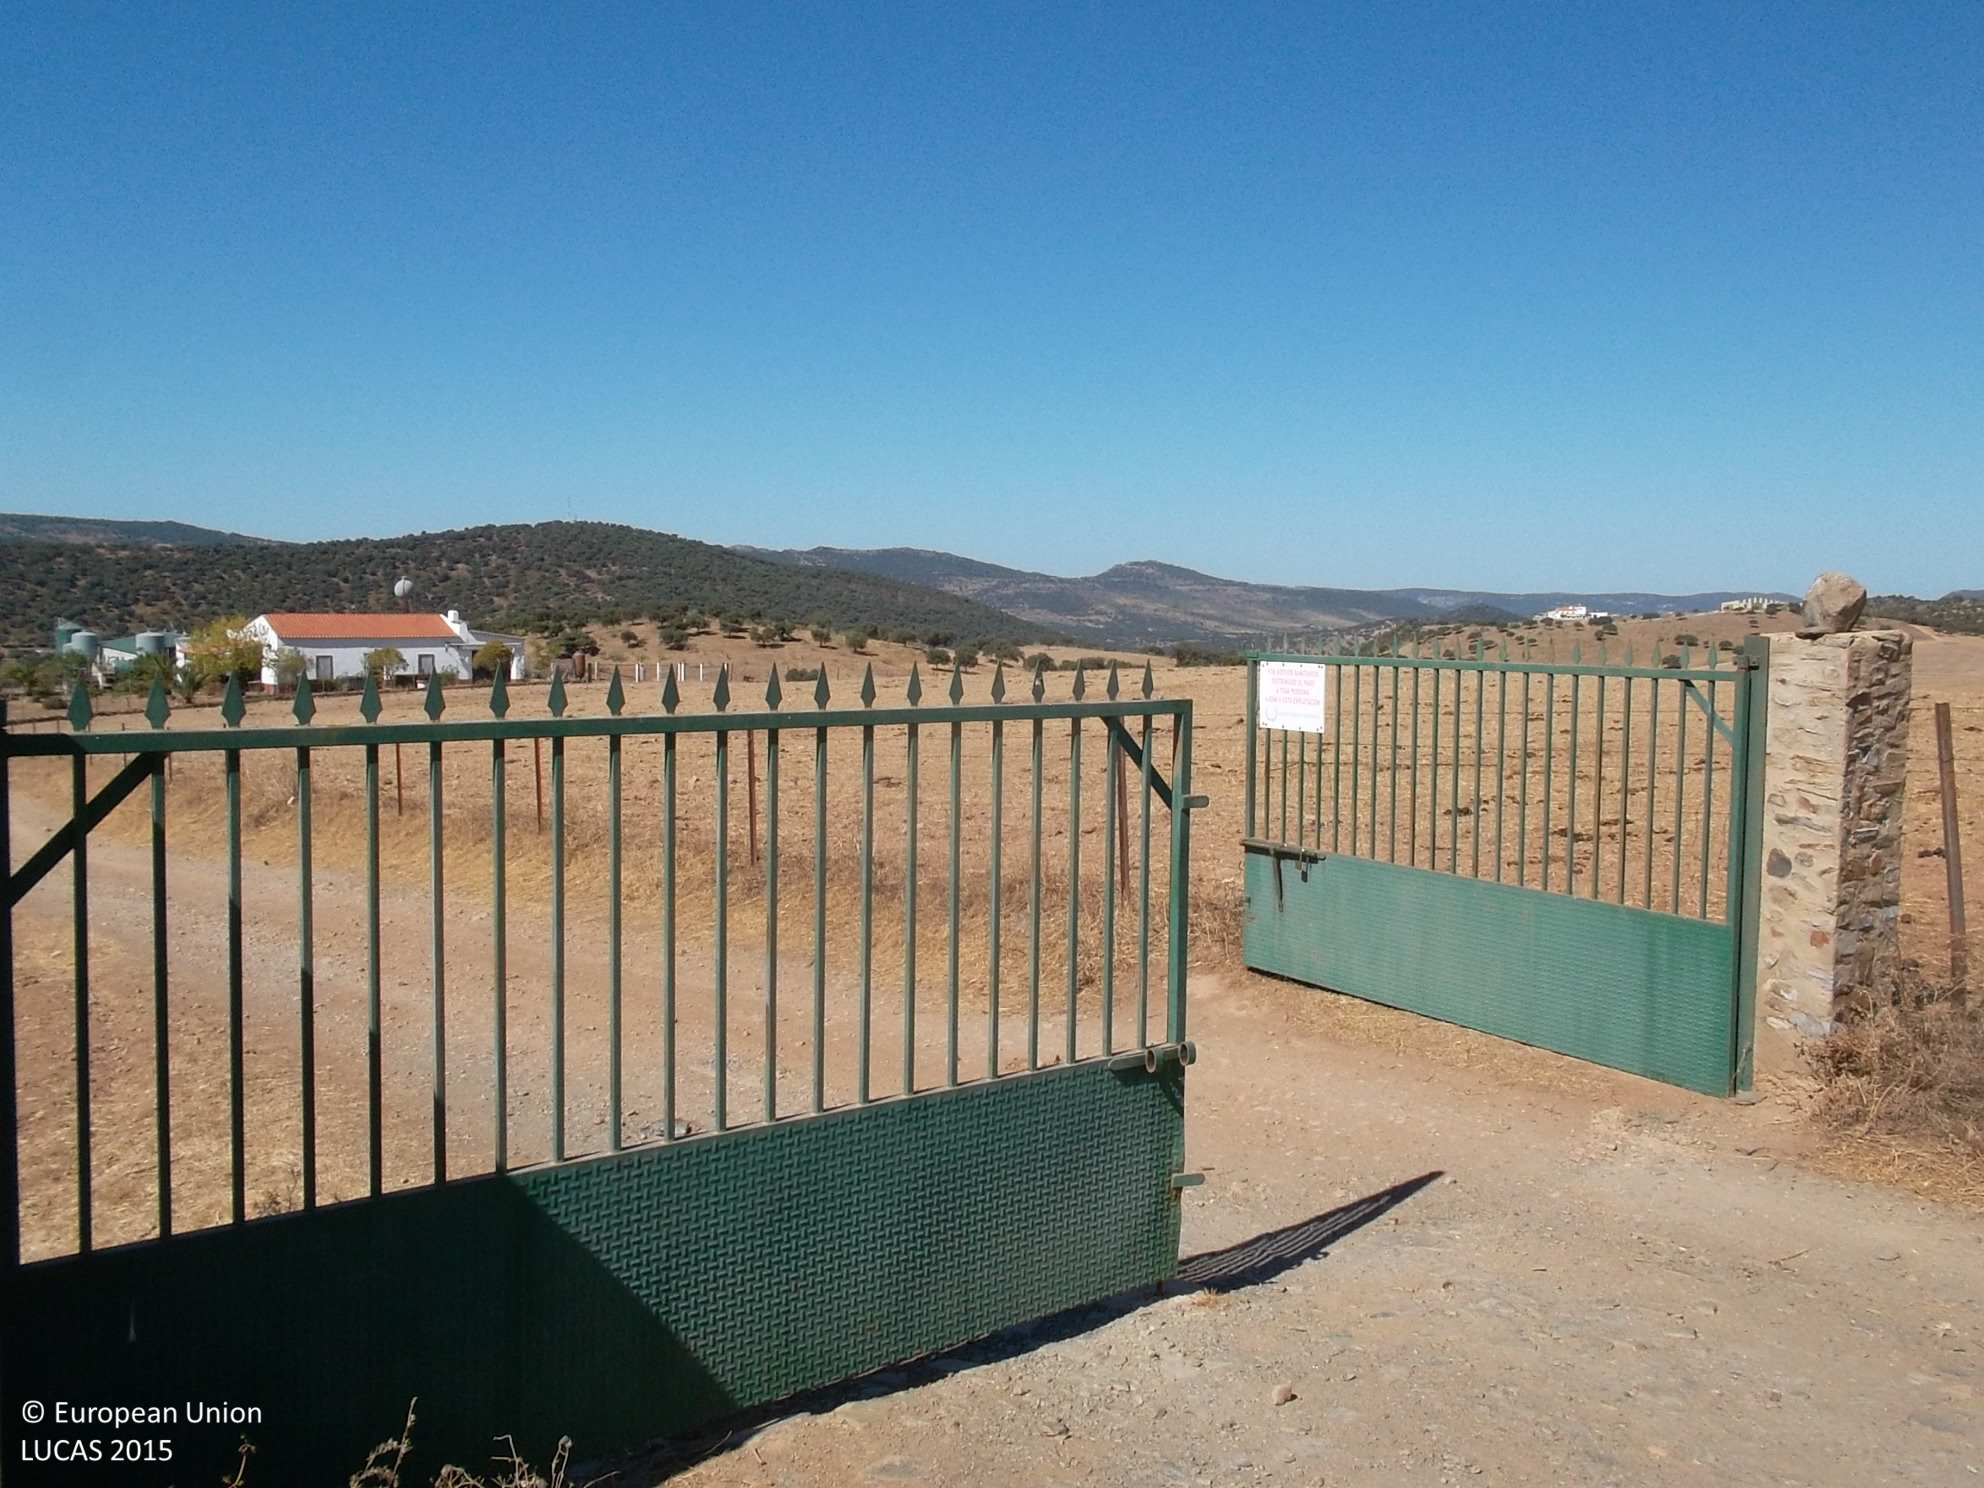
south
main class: Grassland
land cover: Grassland with sparse tree/shrub cover
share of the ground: > 75 %
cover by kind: herbaceous plants 90 %, broadleaved forest trees 5 %, shrubs 5 %
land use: Agriculture (excluding fallow land and kitchen gardens)
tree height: < 5 m
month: August
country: ES
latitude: 38.5194
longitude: -6.6530
